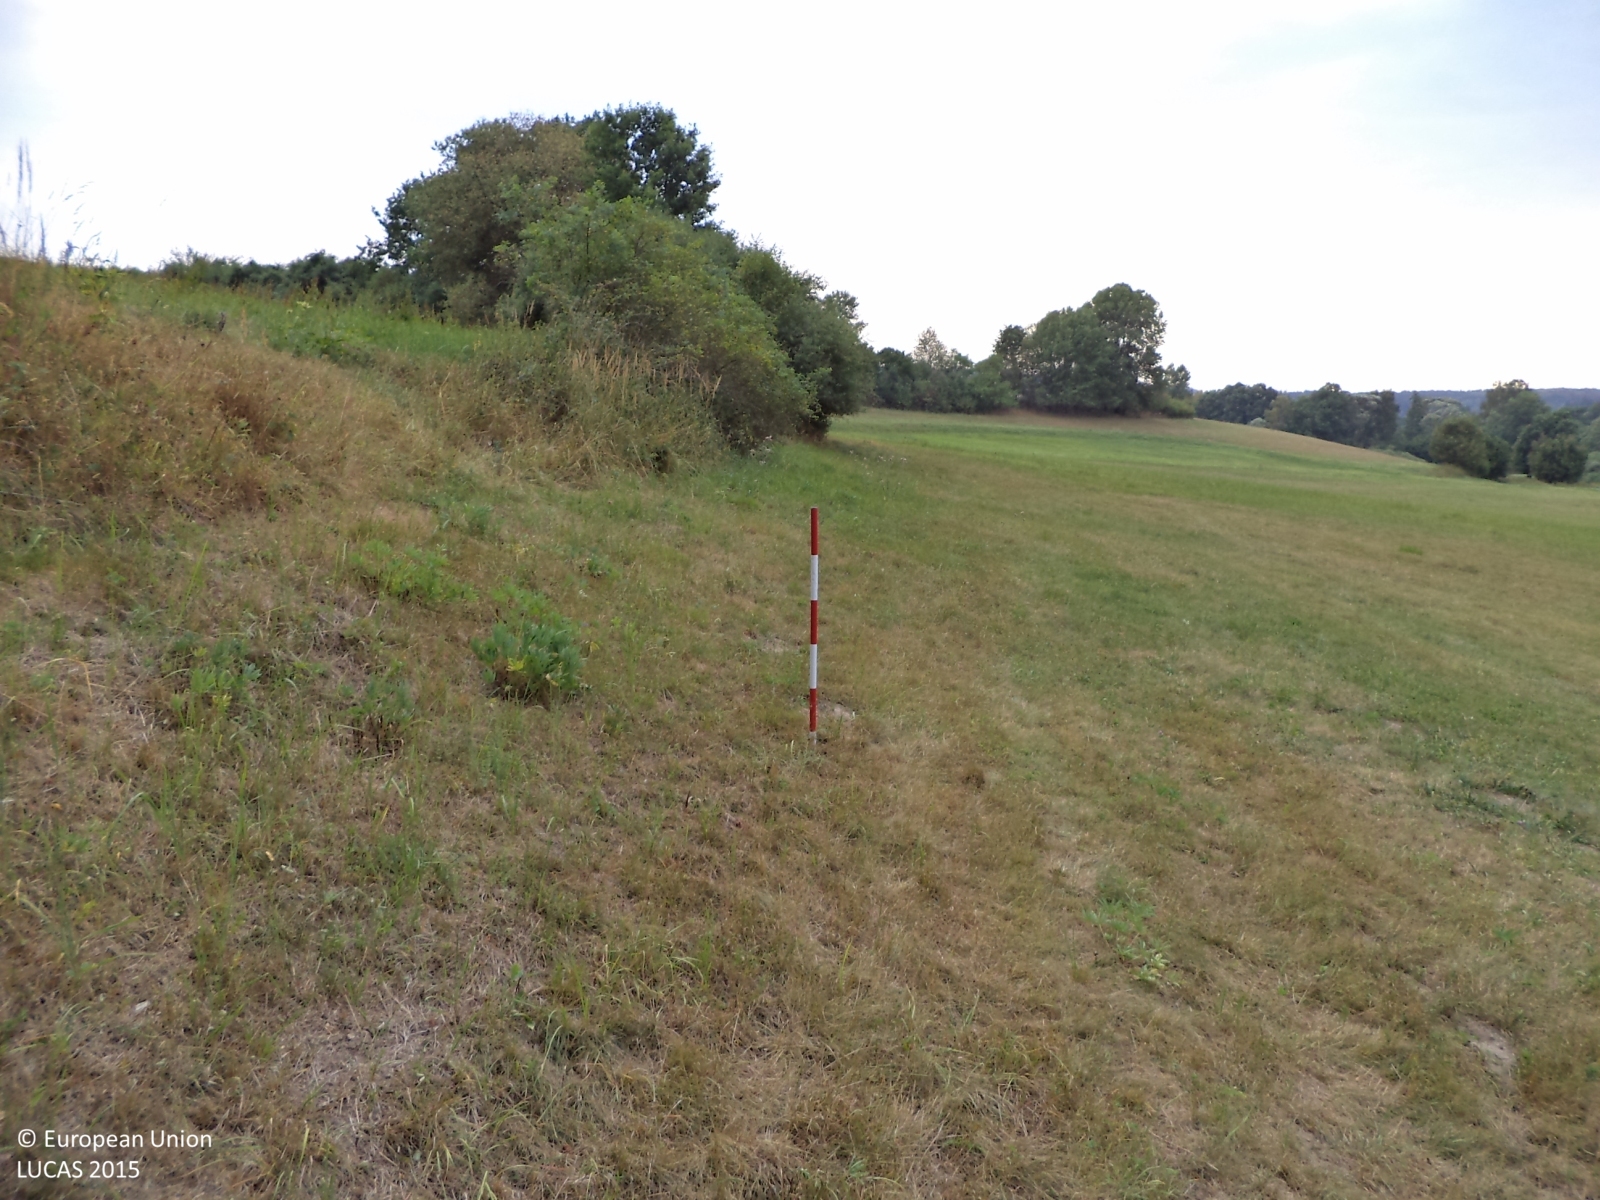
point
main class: Grassland
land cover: Grassland without tree/shrub cover
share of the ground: > 75 %
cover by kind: herbaceous plants 100 %
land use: Agriculture (excluding fallow land and kitchen gardens)
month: August
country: CZ
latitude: 49.4699
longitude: 14.3757
